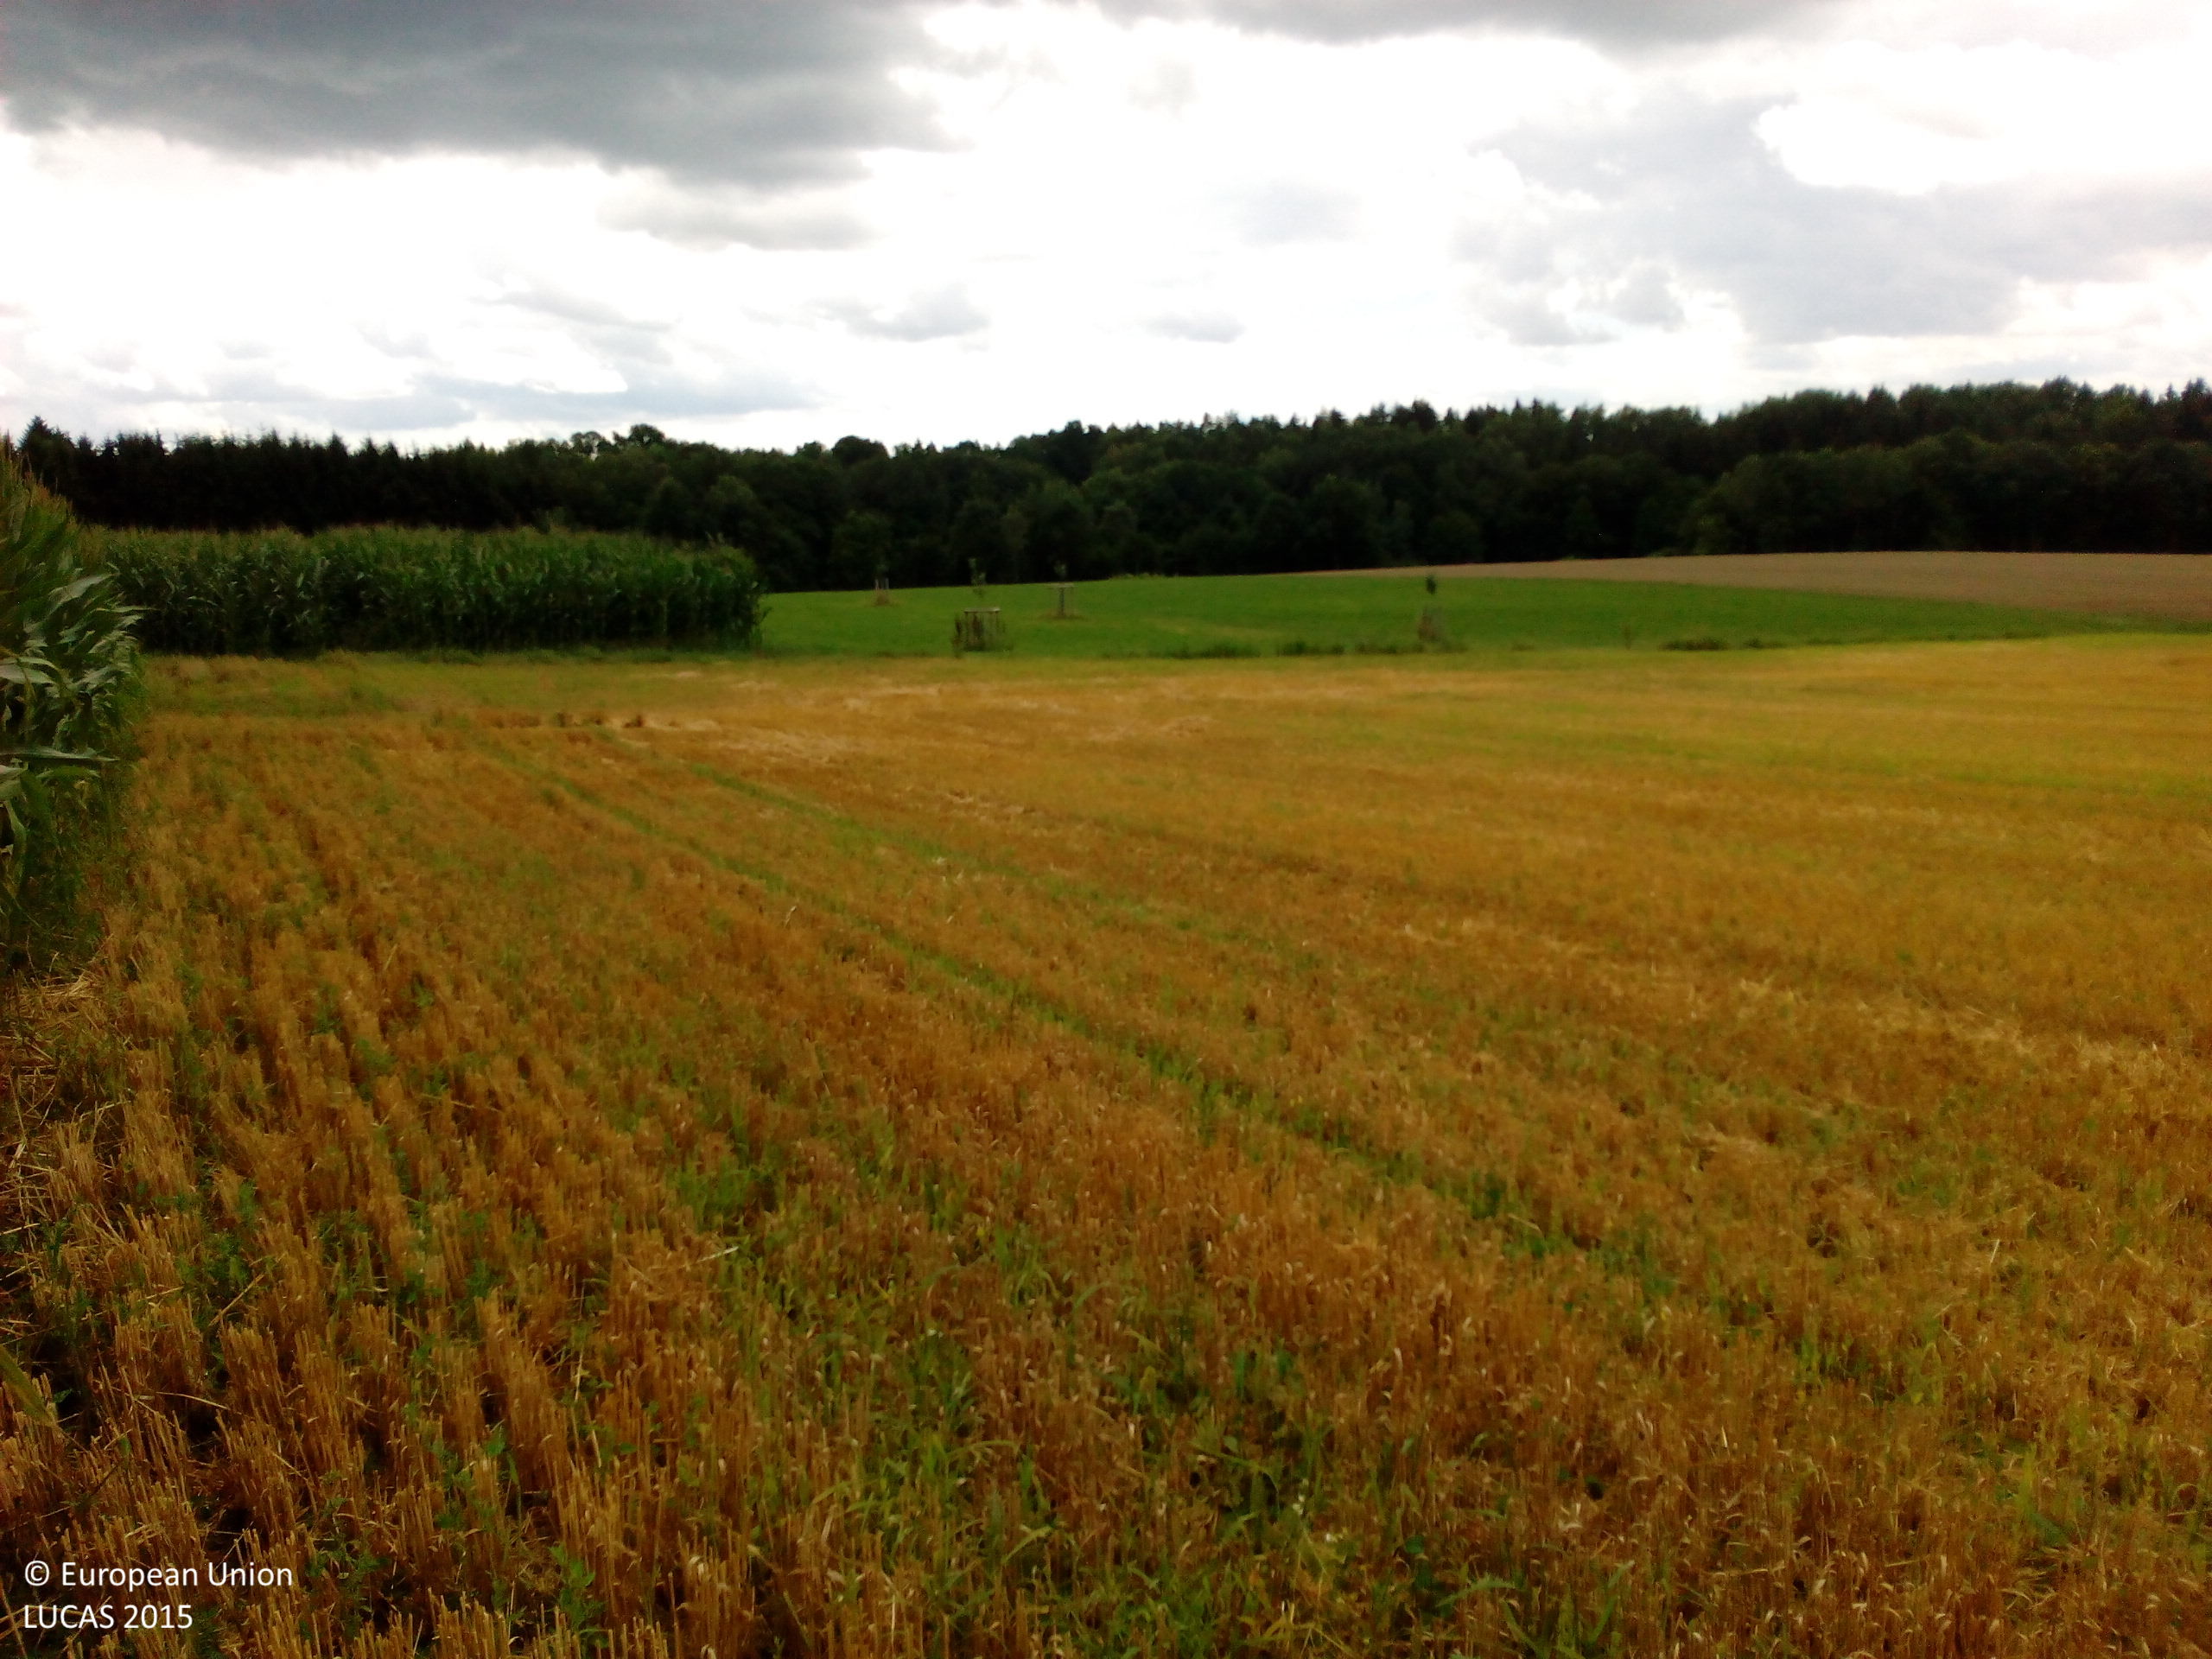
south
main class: Cropland
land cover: Maize
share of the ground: > 75 %
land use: Agriculture (excluding fallow land and kitchen gardens)
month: July
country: DE
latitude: 48.8688
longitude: 12.9306
